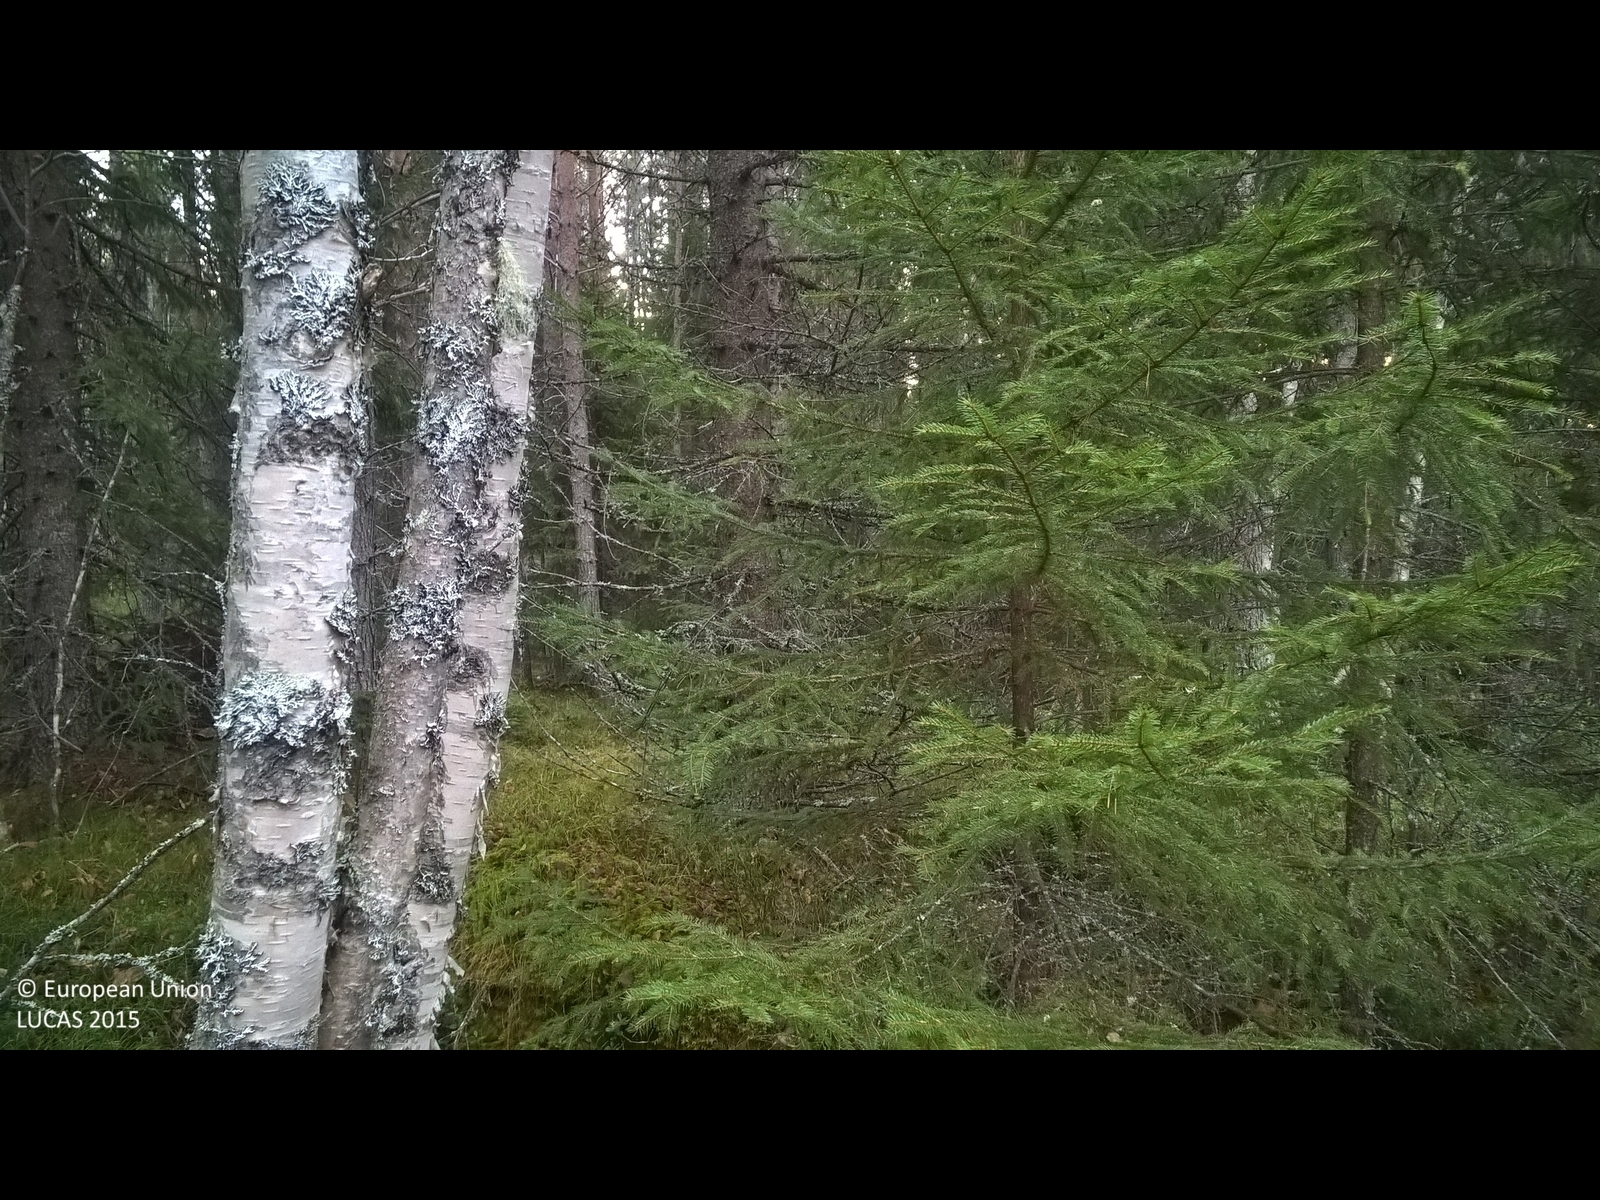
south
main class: Woodland
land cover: Spruce dominated mixed woodland
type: boreal forest
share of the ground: > 75 %
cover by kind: coniferous forest trees 40 %, broadleaved forest trees 40 %, lichens and mosses 20 %
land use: Forestry
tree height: > 5 m
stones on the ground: < 10 %
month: November
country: SE
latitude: 62.7599
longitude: 15.6379
